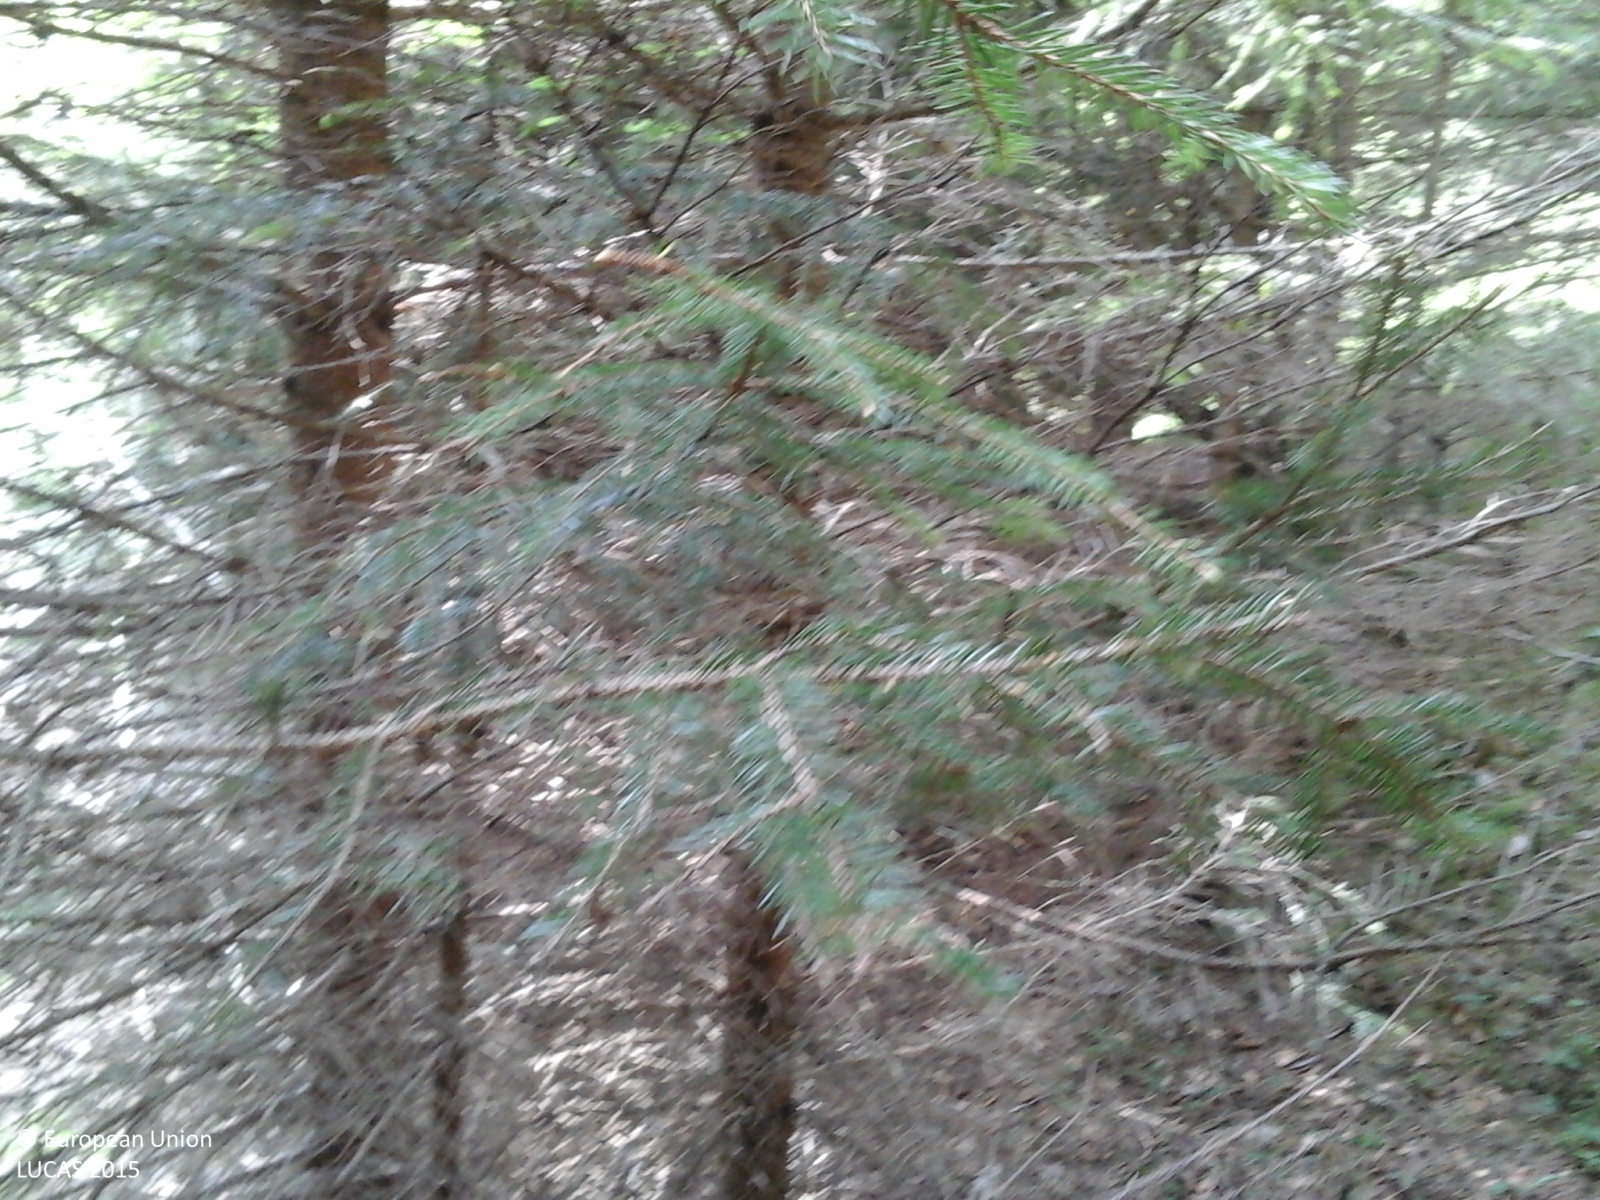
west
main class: Woodland
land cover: Spruce dominated coniferous woodland
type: alpine coniferous forest
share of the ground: > 75 %
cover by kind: coniferous forest trees 100 %
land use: Forestry
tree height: > 5 m
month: May
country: IT
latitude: 46.1892
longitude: 11.9540
